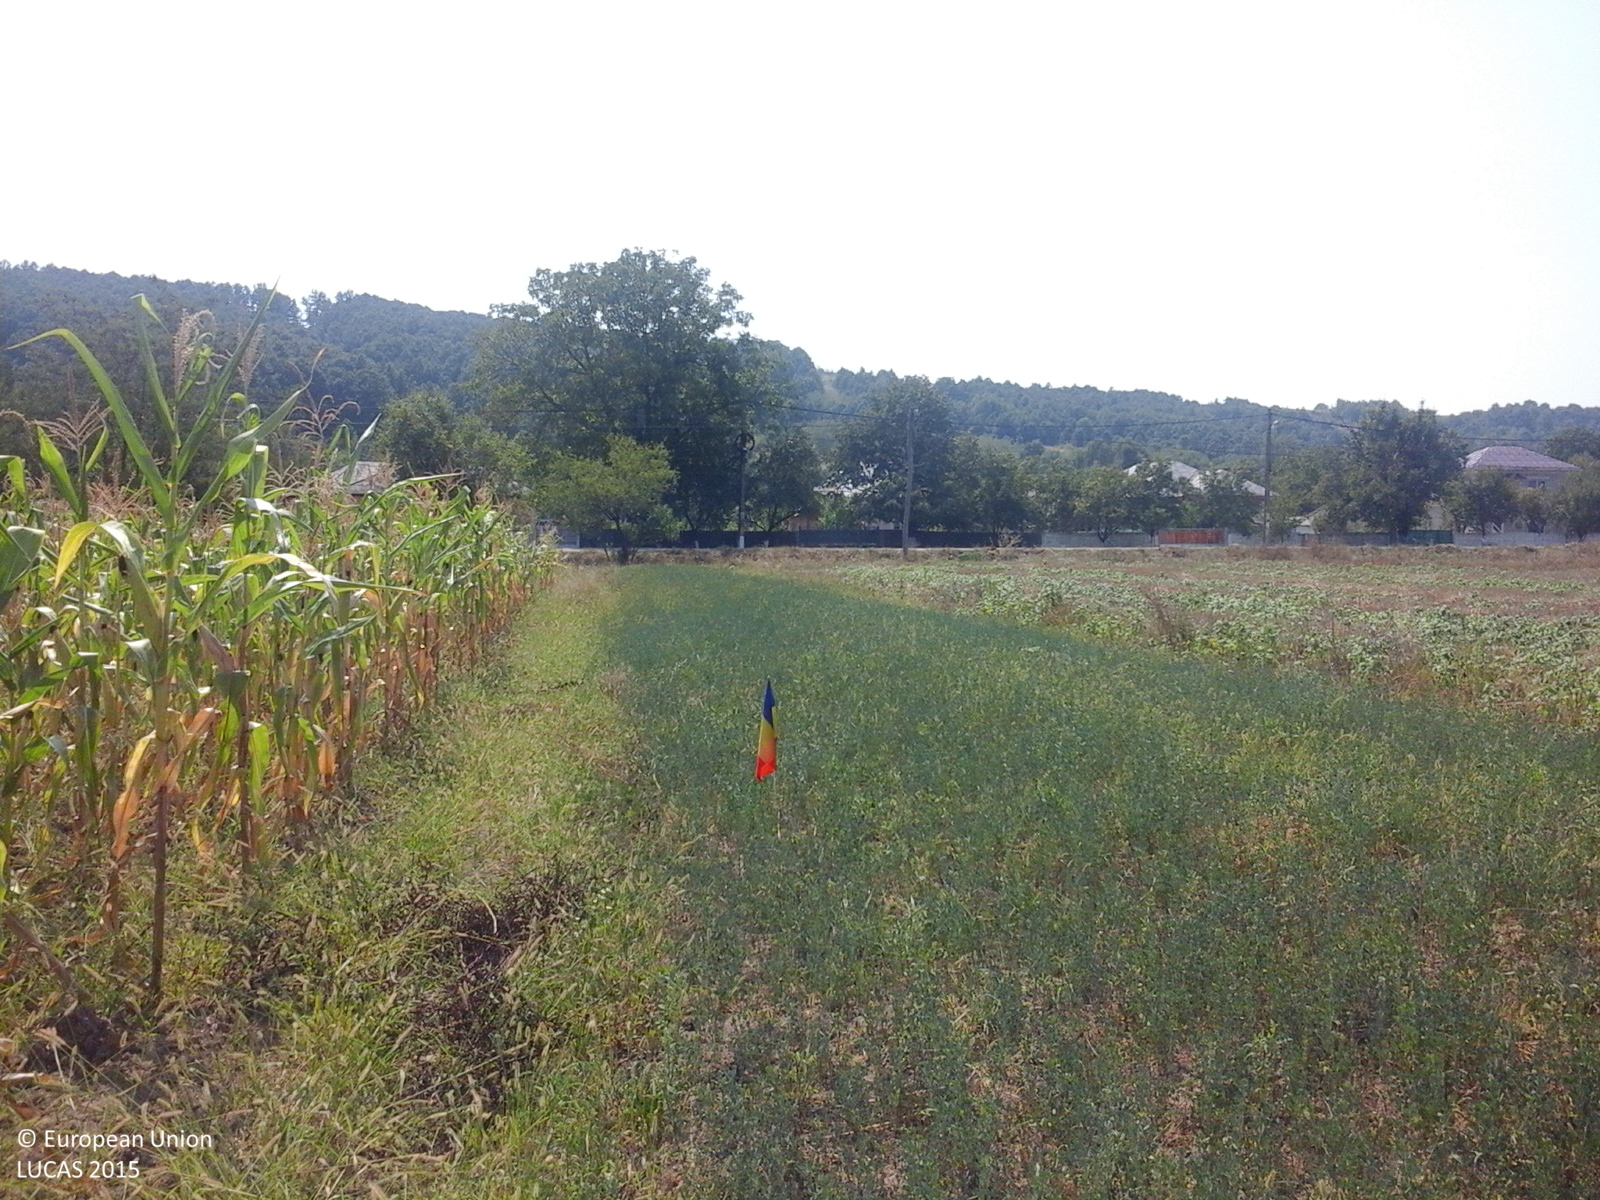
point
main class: Cropland
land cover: Lucerne
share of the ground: > 75 %
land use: Agriculture (excluding fallow land and kitchen gardens)
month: August
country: RO
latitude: 44.6357
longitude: 23.8901
